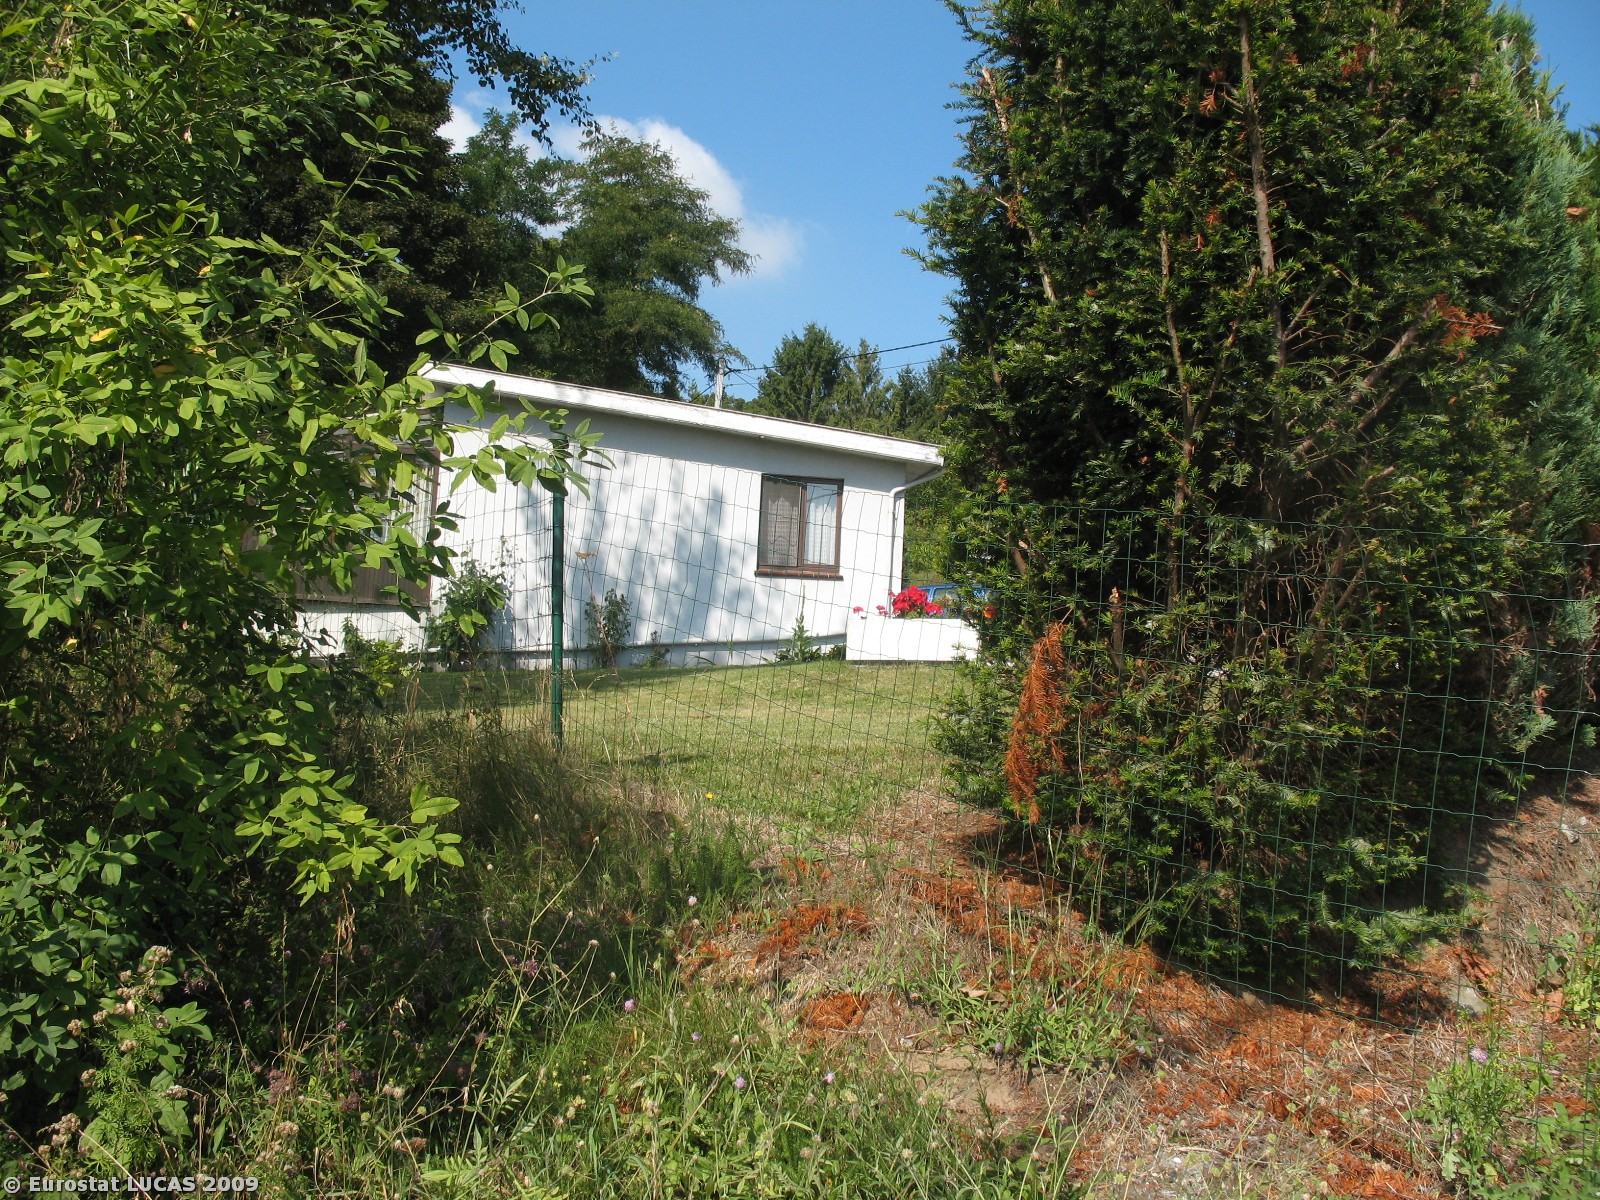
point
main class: Artificial land
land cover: Buildings with 1 to 3 floors
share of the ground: > 75 %
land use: Residential
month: August
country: BE
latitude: 50.6916
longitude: 4.3188
